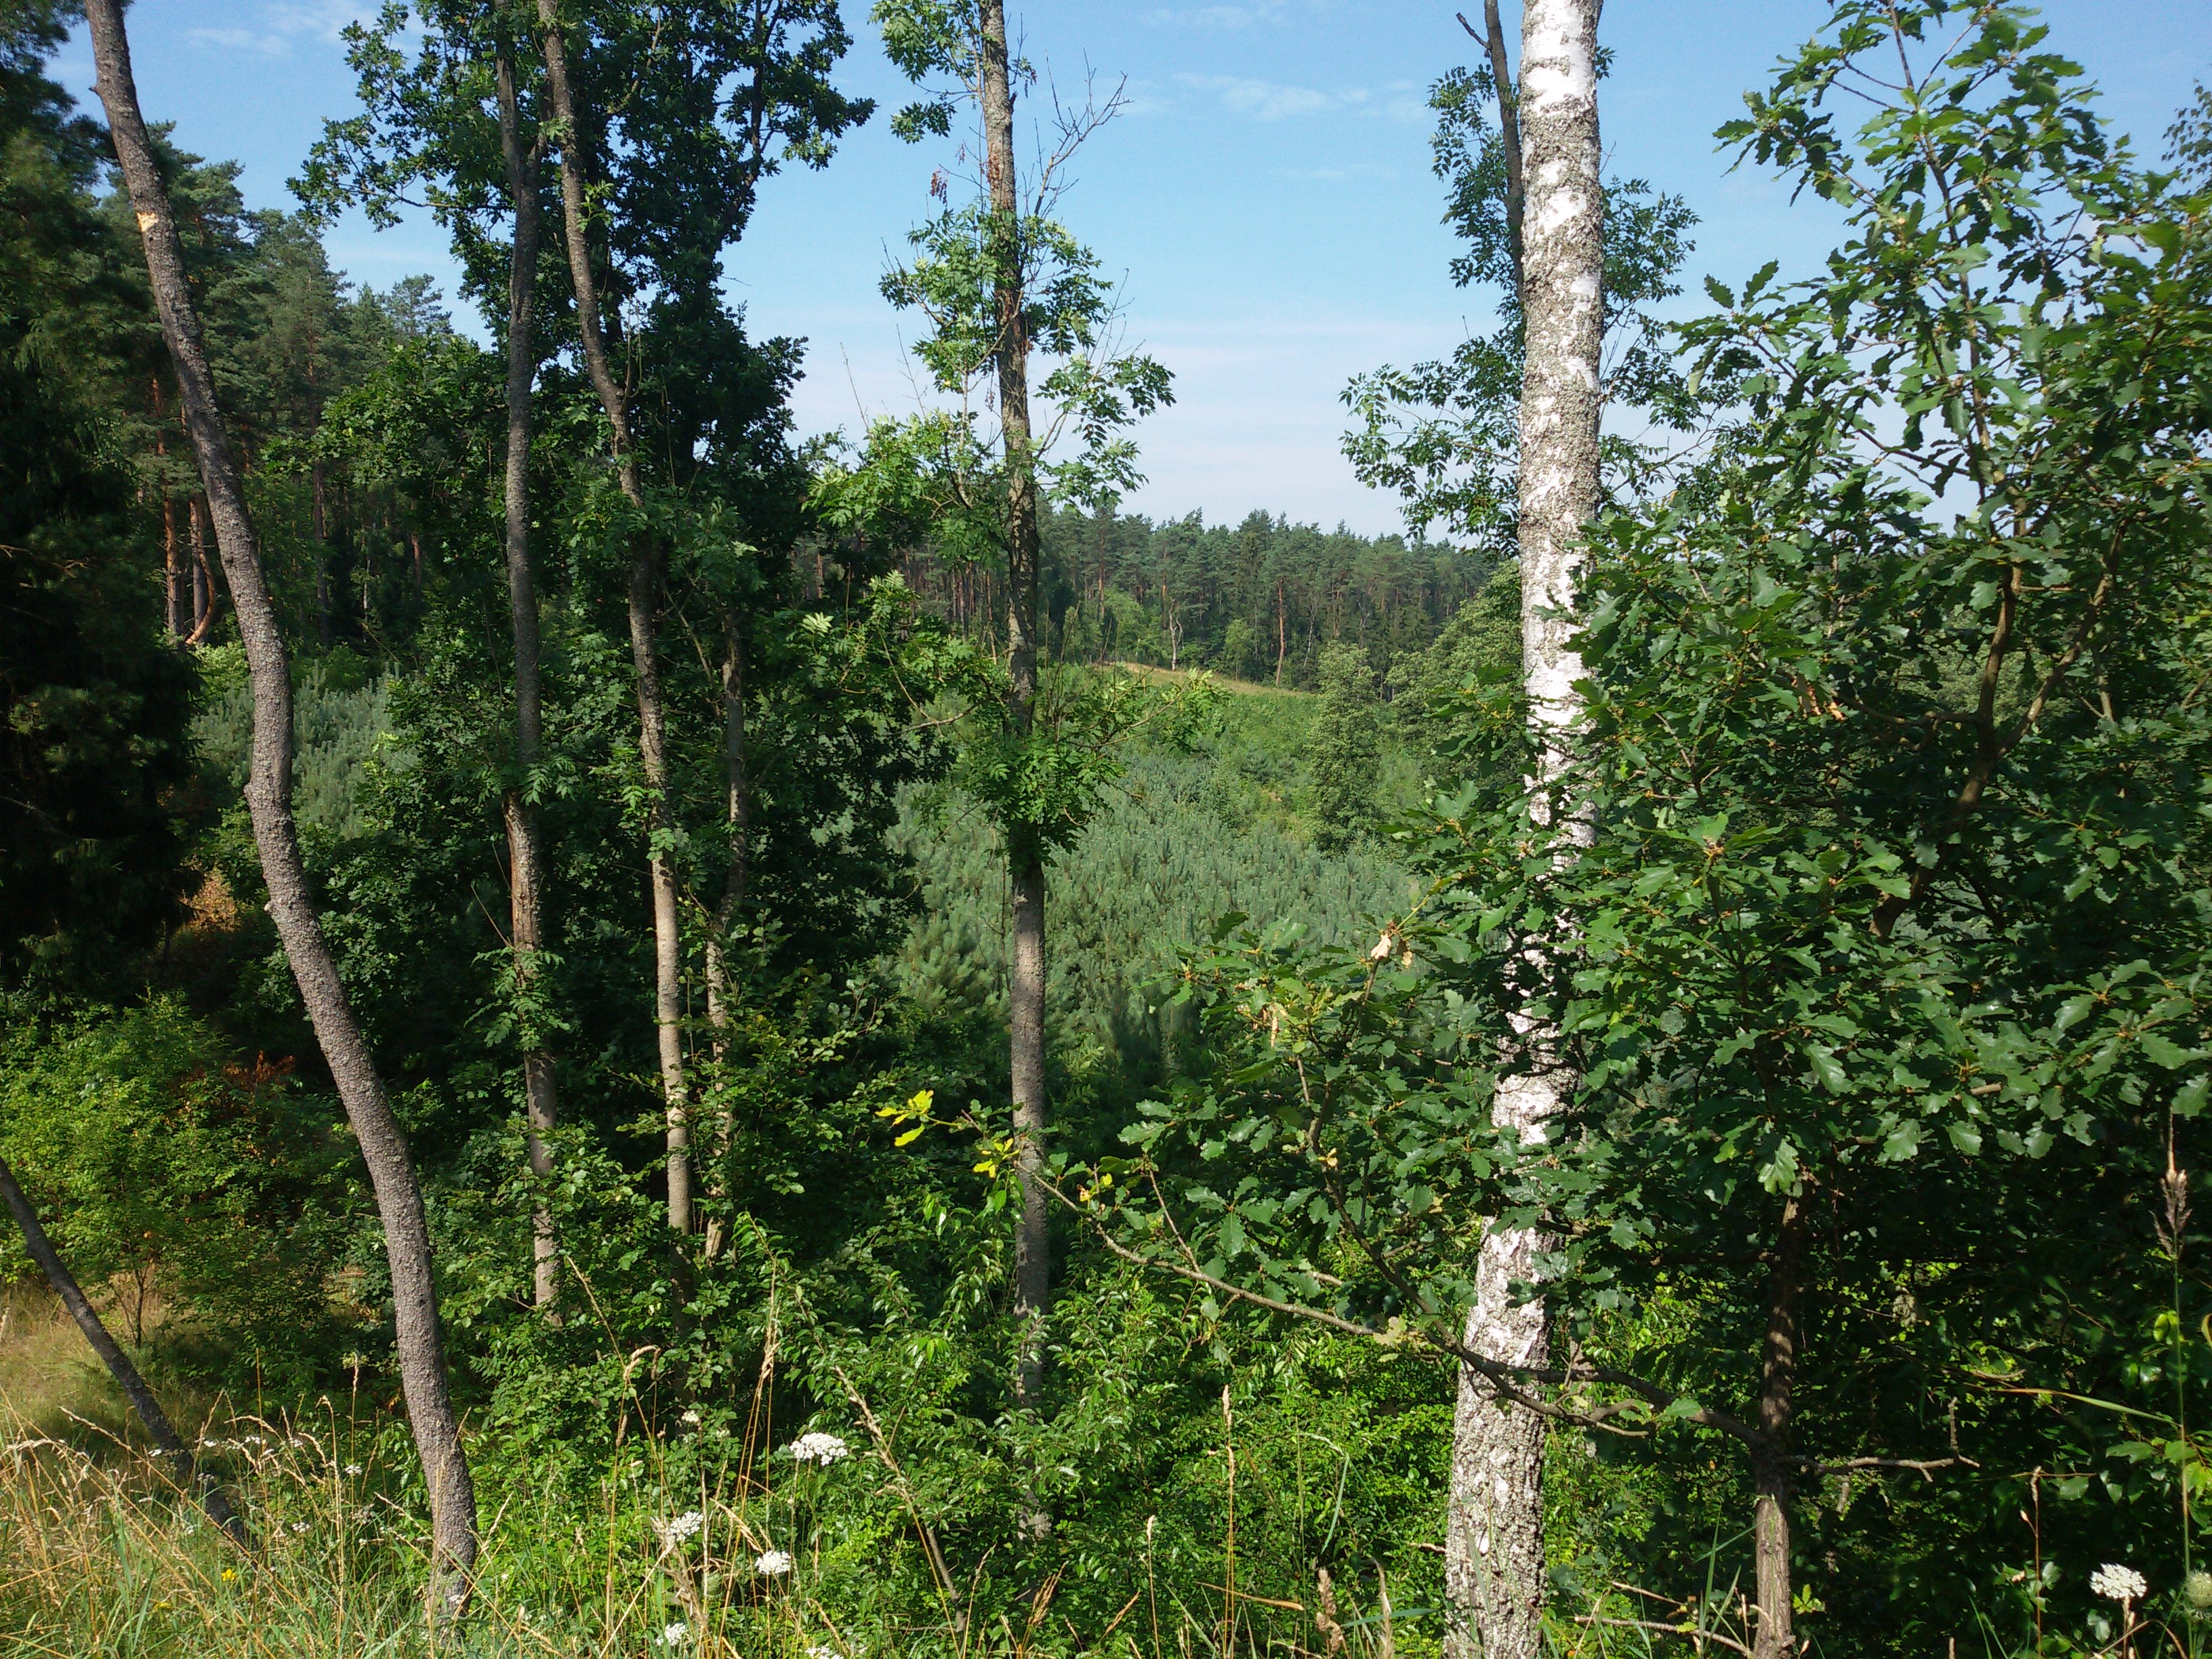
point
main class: Woodland
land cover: Pine dominated coniferous woodland
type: hemiboreal forest and nemoral coniferous forest and mixed broadleaved-coniferous forest
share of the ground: > 75 %
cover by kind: coniferous forest trees 90 %, herbaceous plants 10 %
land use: Forestry
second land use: Community services
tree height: < 5 m
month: August
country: PL
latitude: 53.4639
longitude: 15.7430
